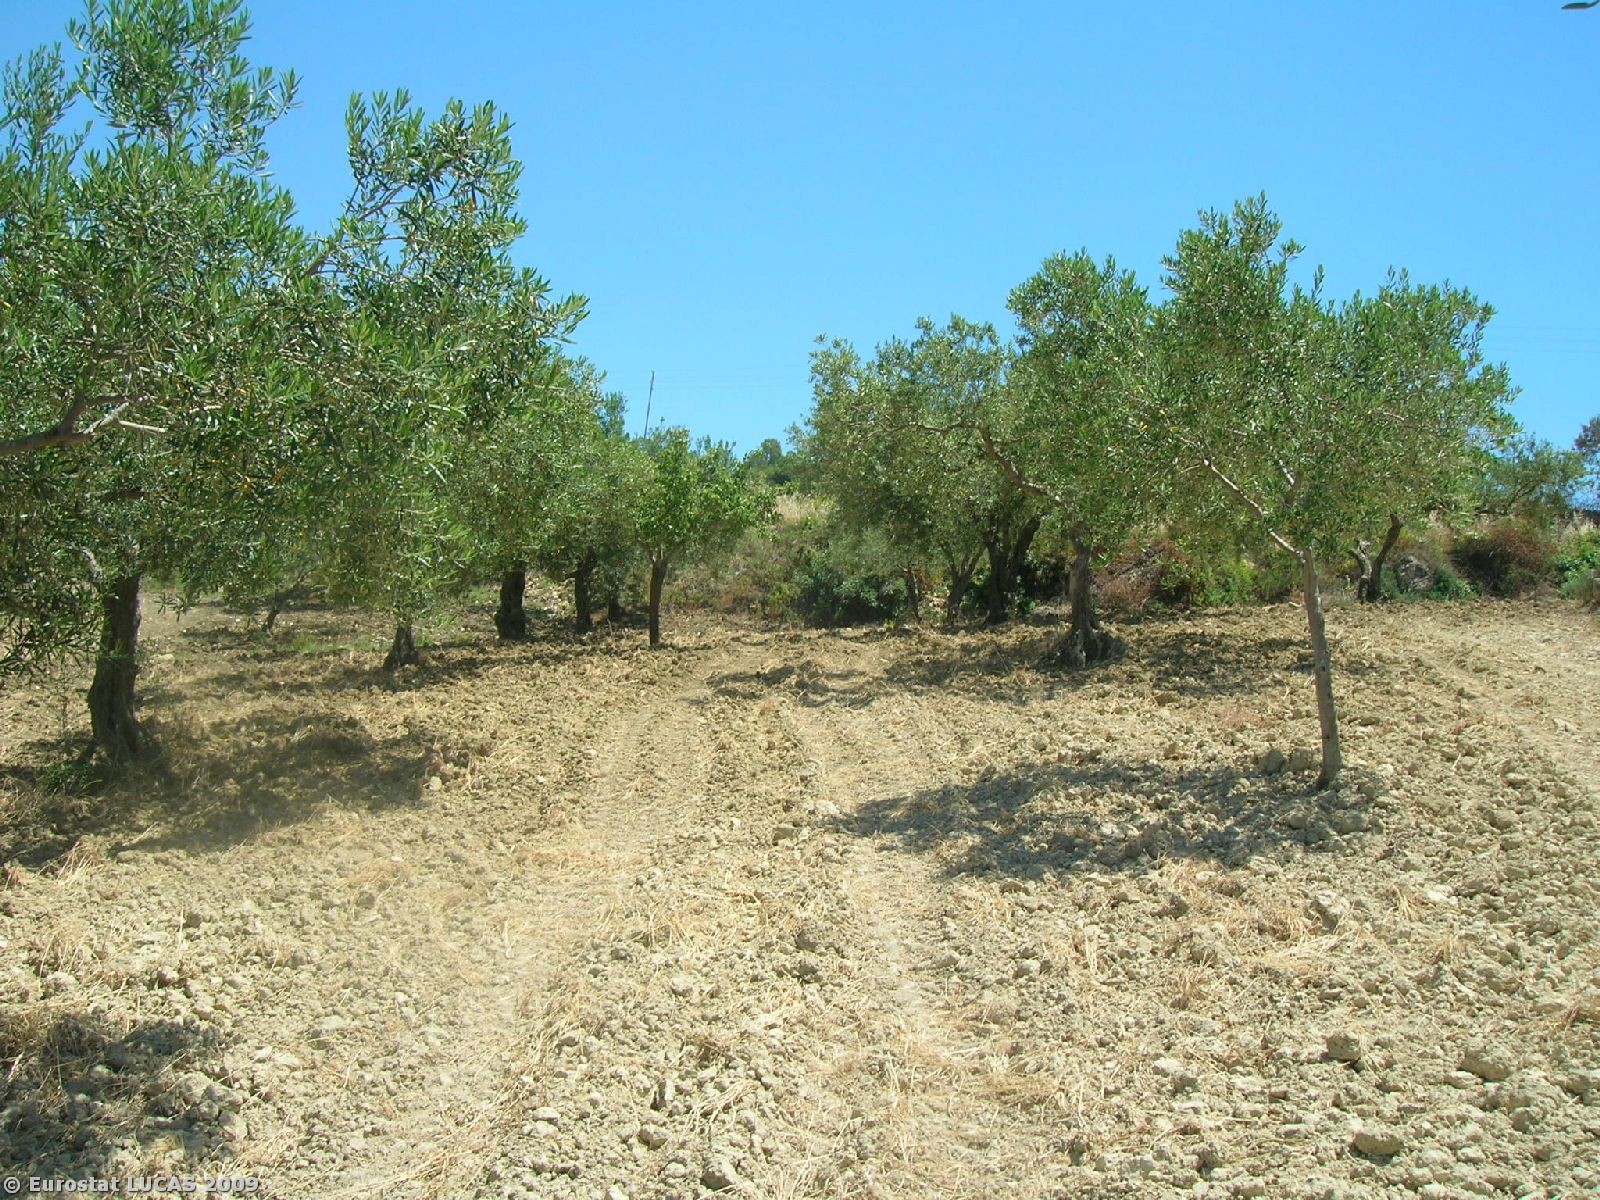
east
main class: Cropland
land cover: Olive groves
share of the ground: 50 - 75 %
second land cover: Bare land
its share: > 75 %
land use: Agriculture (excluding fallow land and kitchen gardens)
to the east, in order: Olive groves; Bare land; Other structural elements; Grass margins; Paved roads, cycling and walking lanes; Spontaneously vegetated surfaces; Shrubland without tree cover; Paved roads, cycling and walking lanes; Shrubland without tree cover
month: June
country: IT
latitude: 37.5332
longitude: 13.1109
